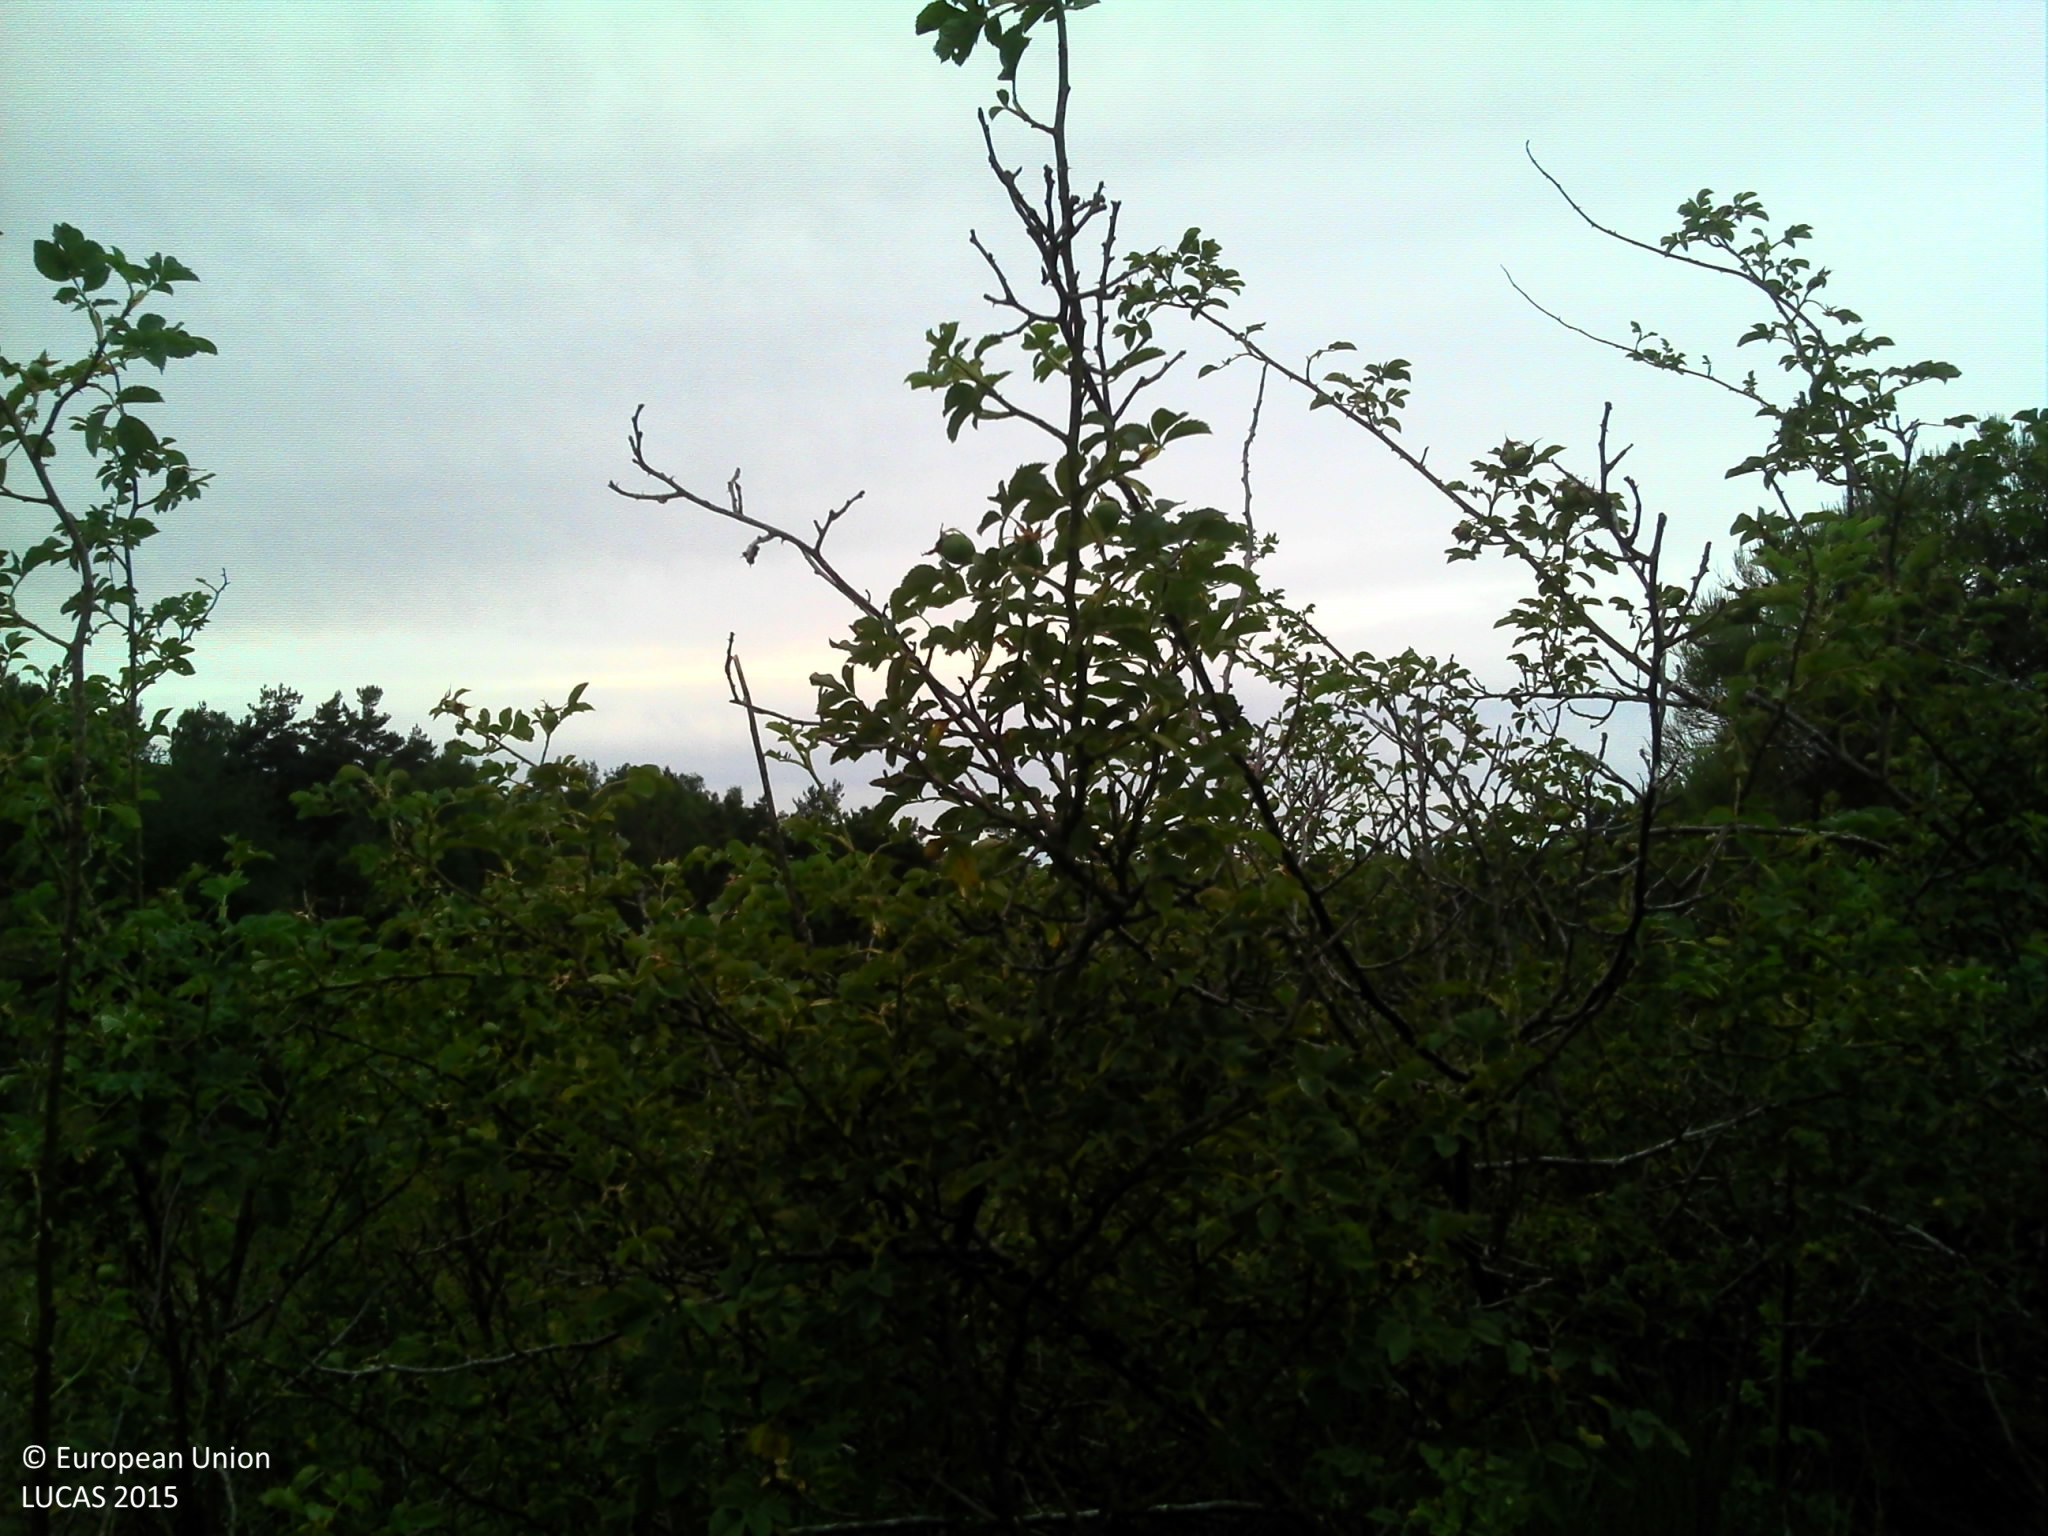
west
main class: Shrubland
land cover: Shrubland without tree cover
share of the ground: > 75 %
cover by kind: shrubs 100 %
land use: Agriculture (excluding fallow land and kitchen gardens)
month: July
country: FR
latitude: 44.6507
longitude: 3.4603
